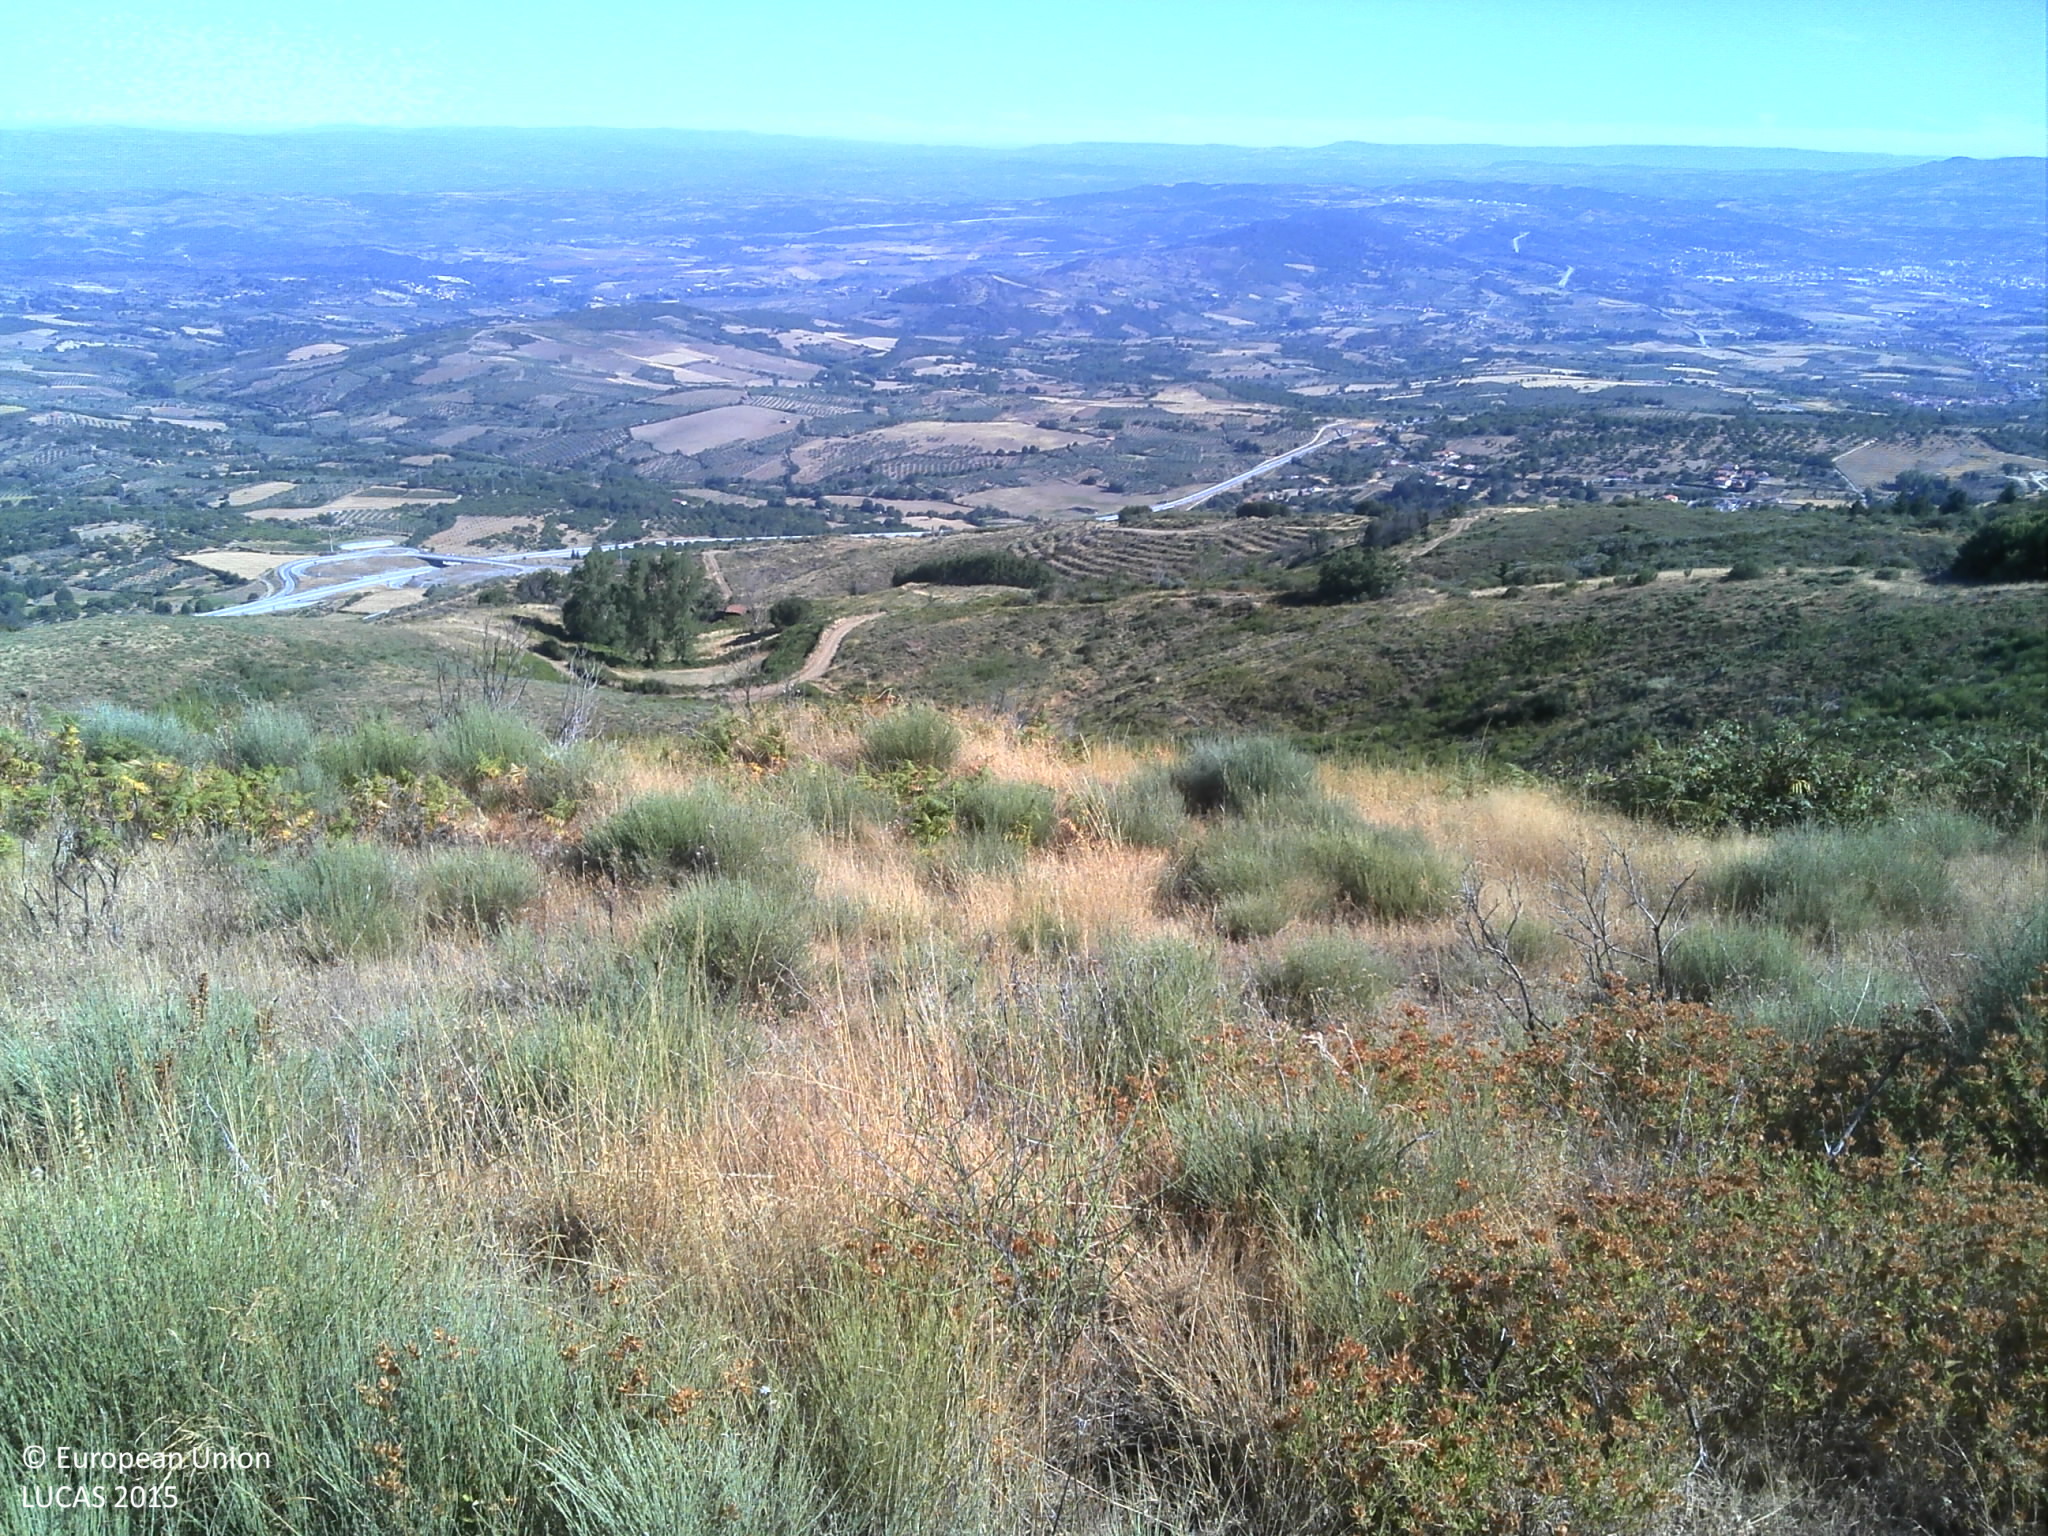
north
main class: Shrubland
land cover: Shrubland without tree cover
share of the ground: > 75 %
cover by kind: shrubs 95 %, herbaceous plants 5 %
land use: Abandoned areas
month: July
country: PT
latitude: 41.4436
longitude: -7.0021
